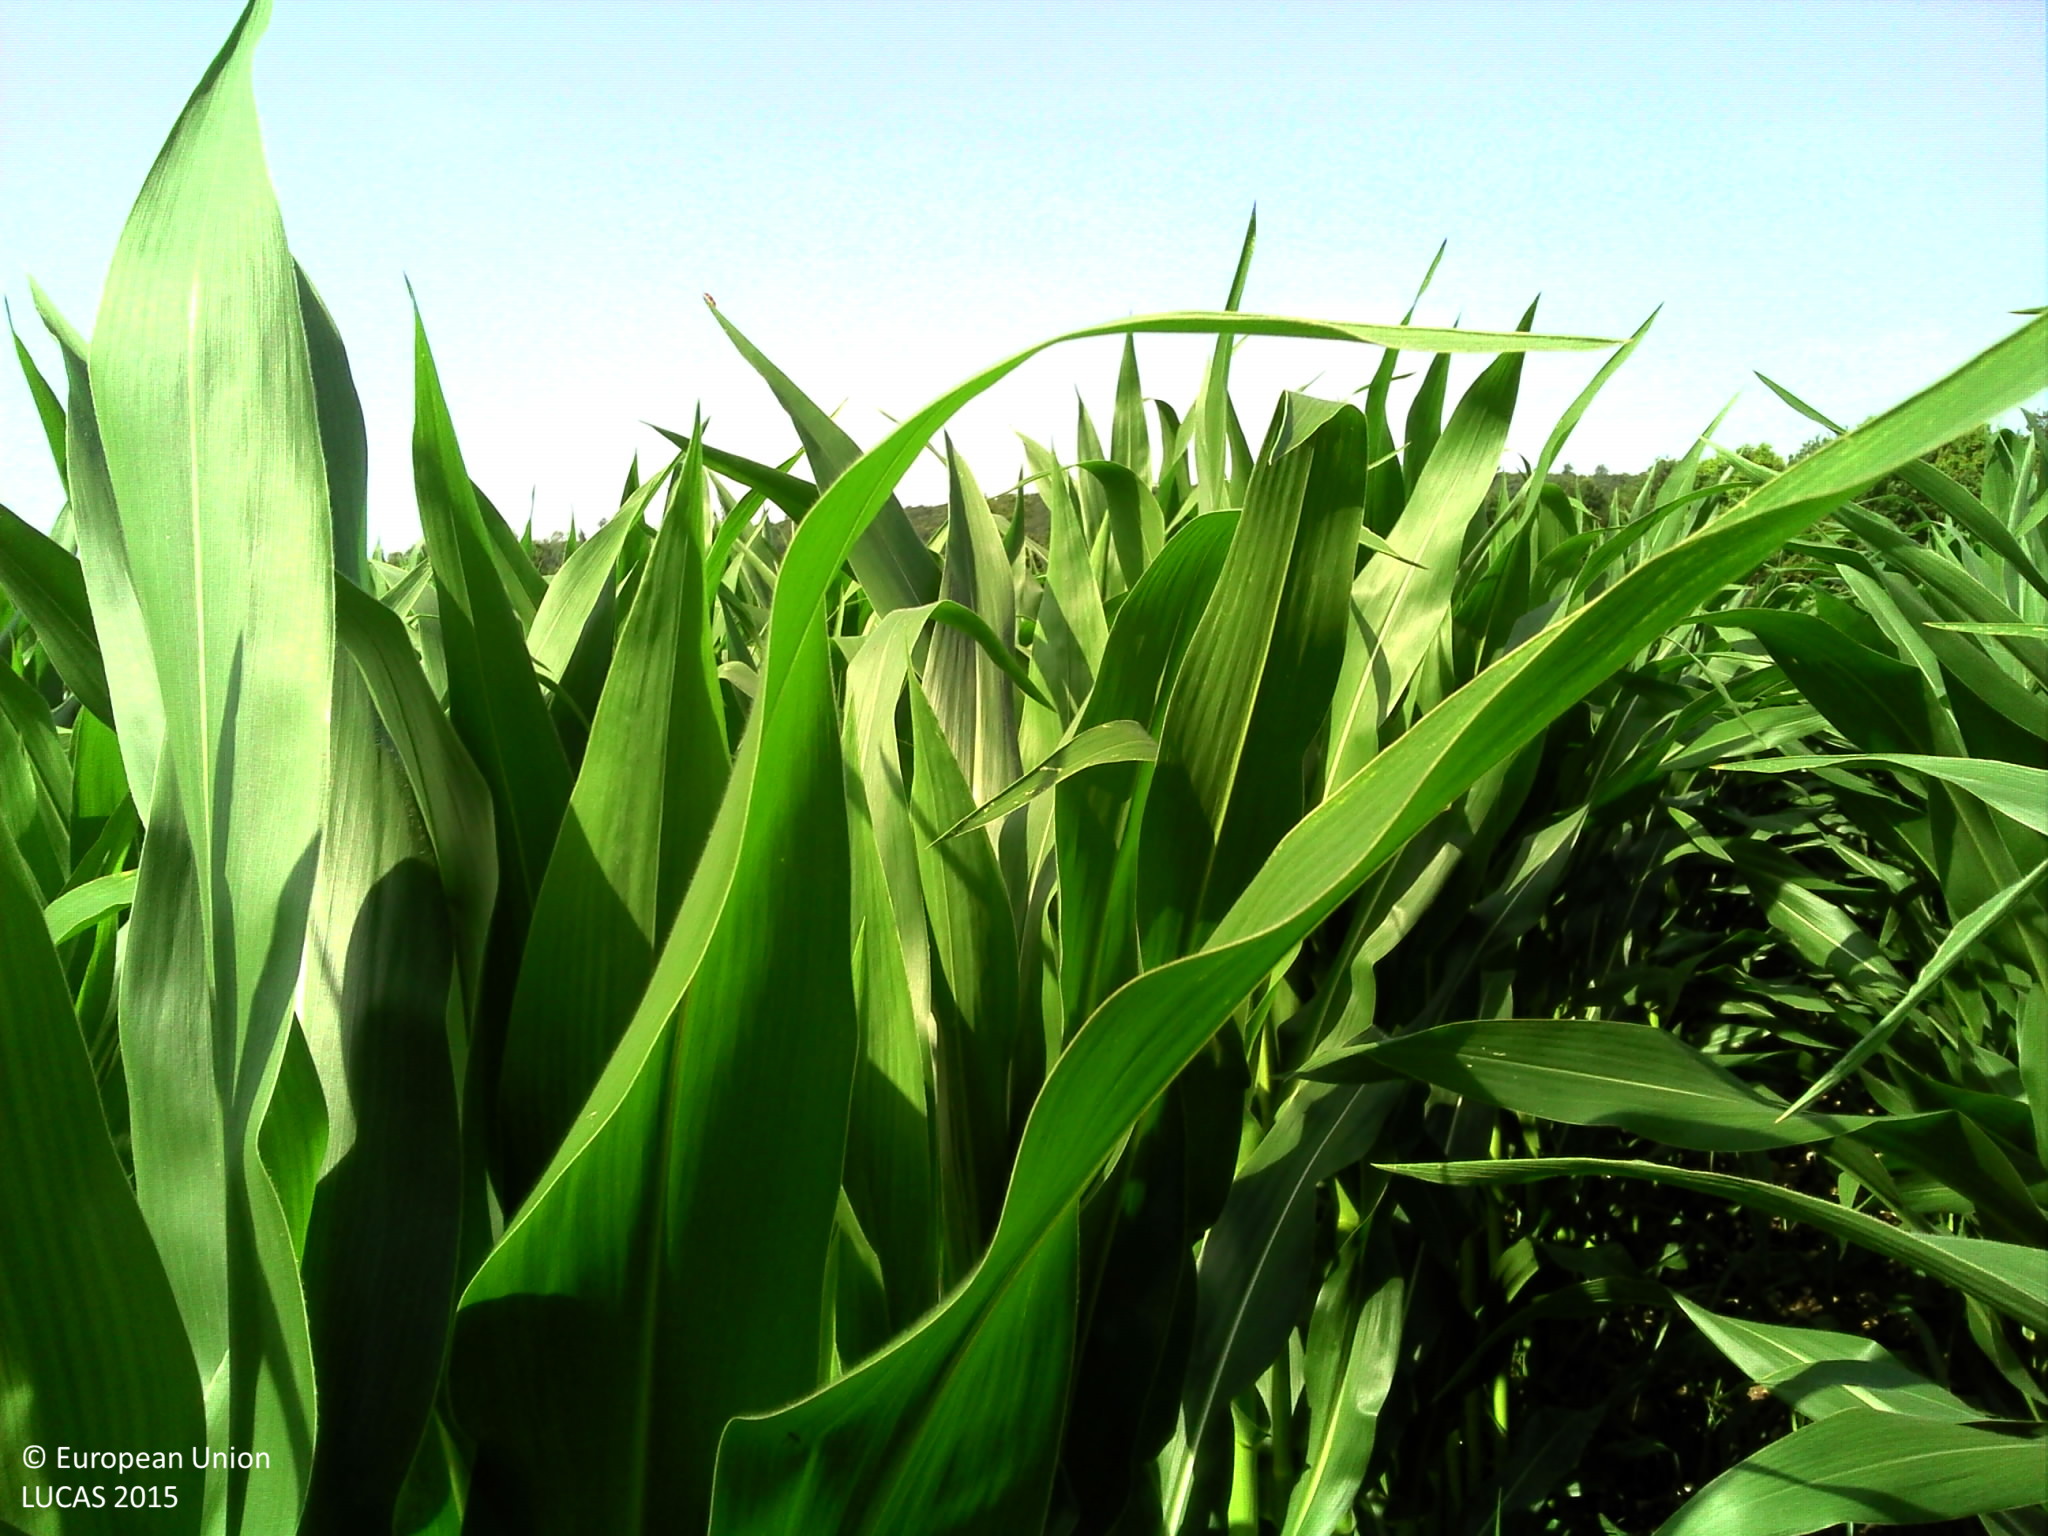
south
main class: Cropland
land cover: Maize
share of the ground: > 75 %
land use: Agriculture (excluding fallow land and kitchen gardens)
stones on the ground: 10 - 25 %
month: July
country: FR
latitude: 45.7646
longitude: 5.3880
